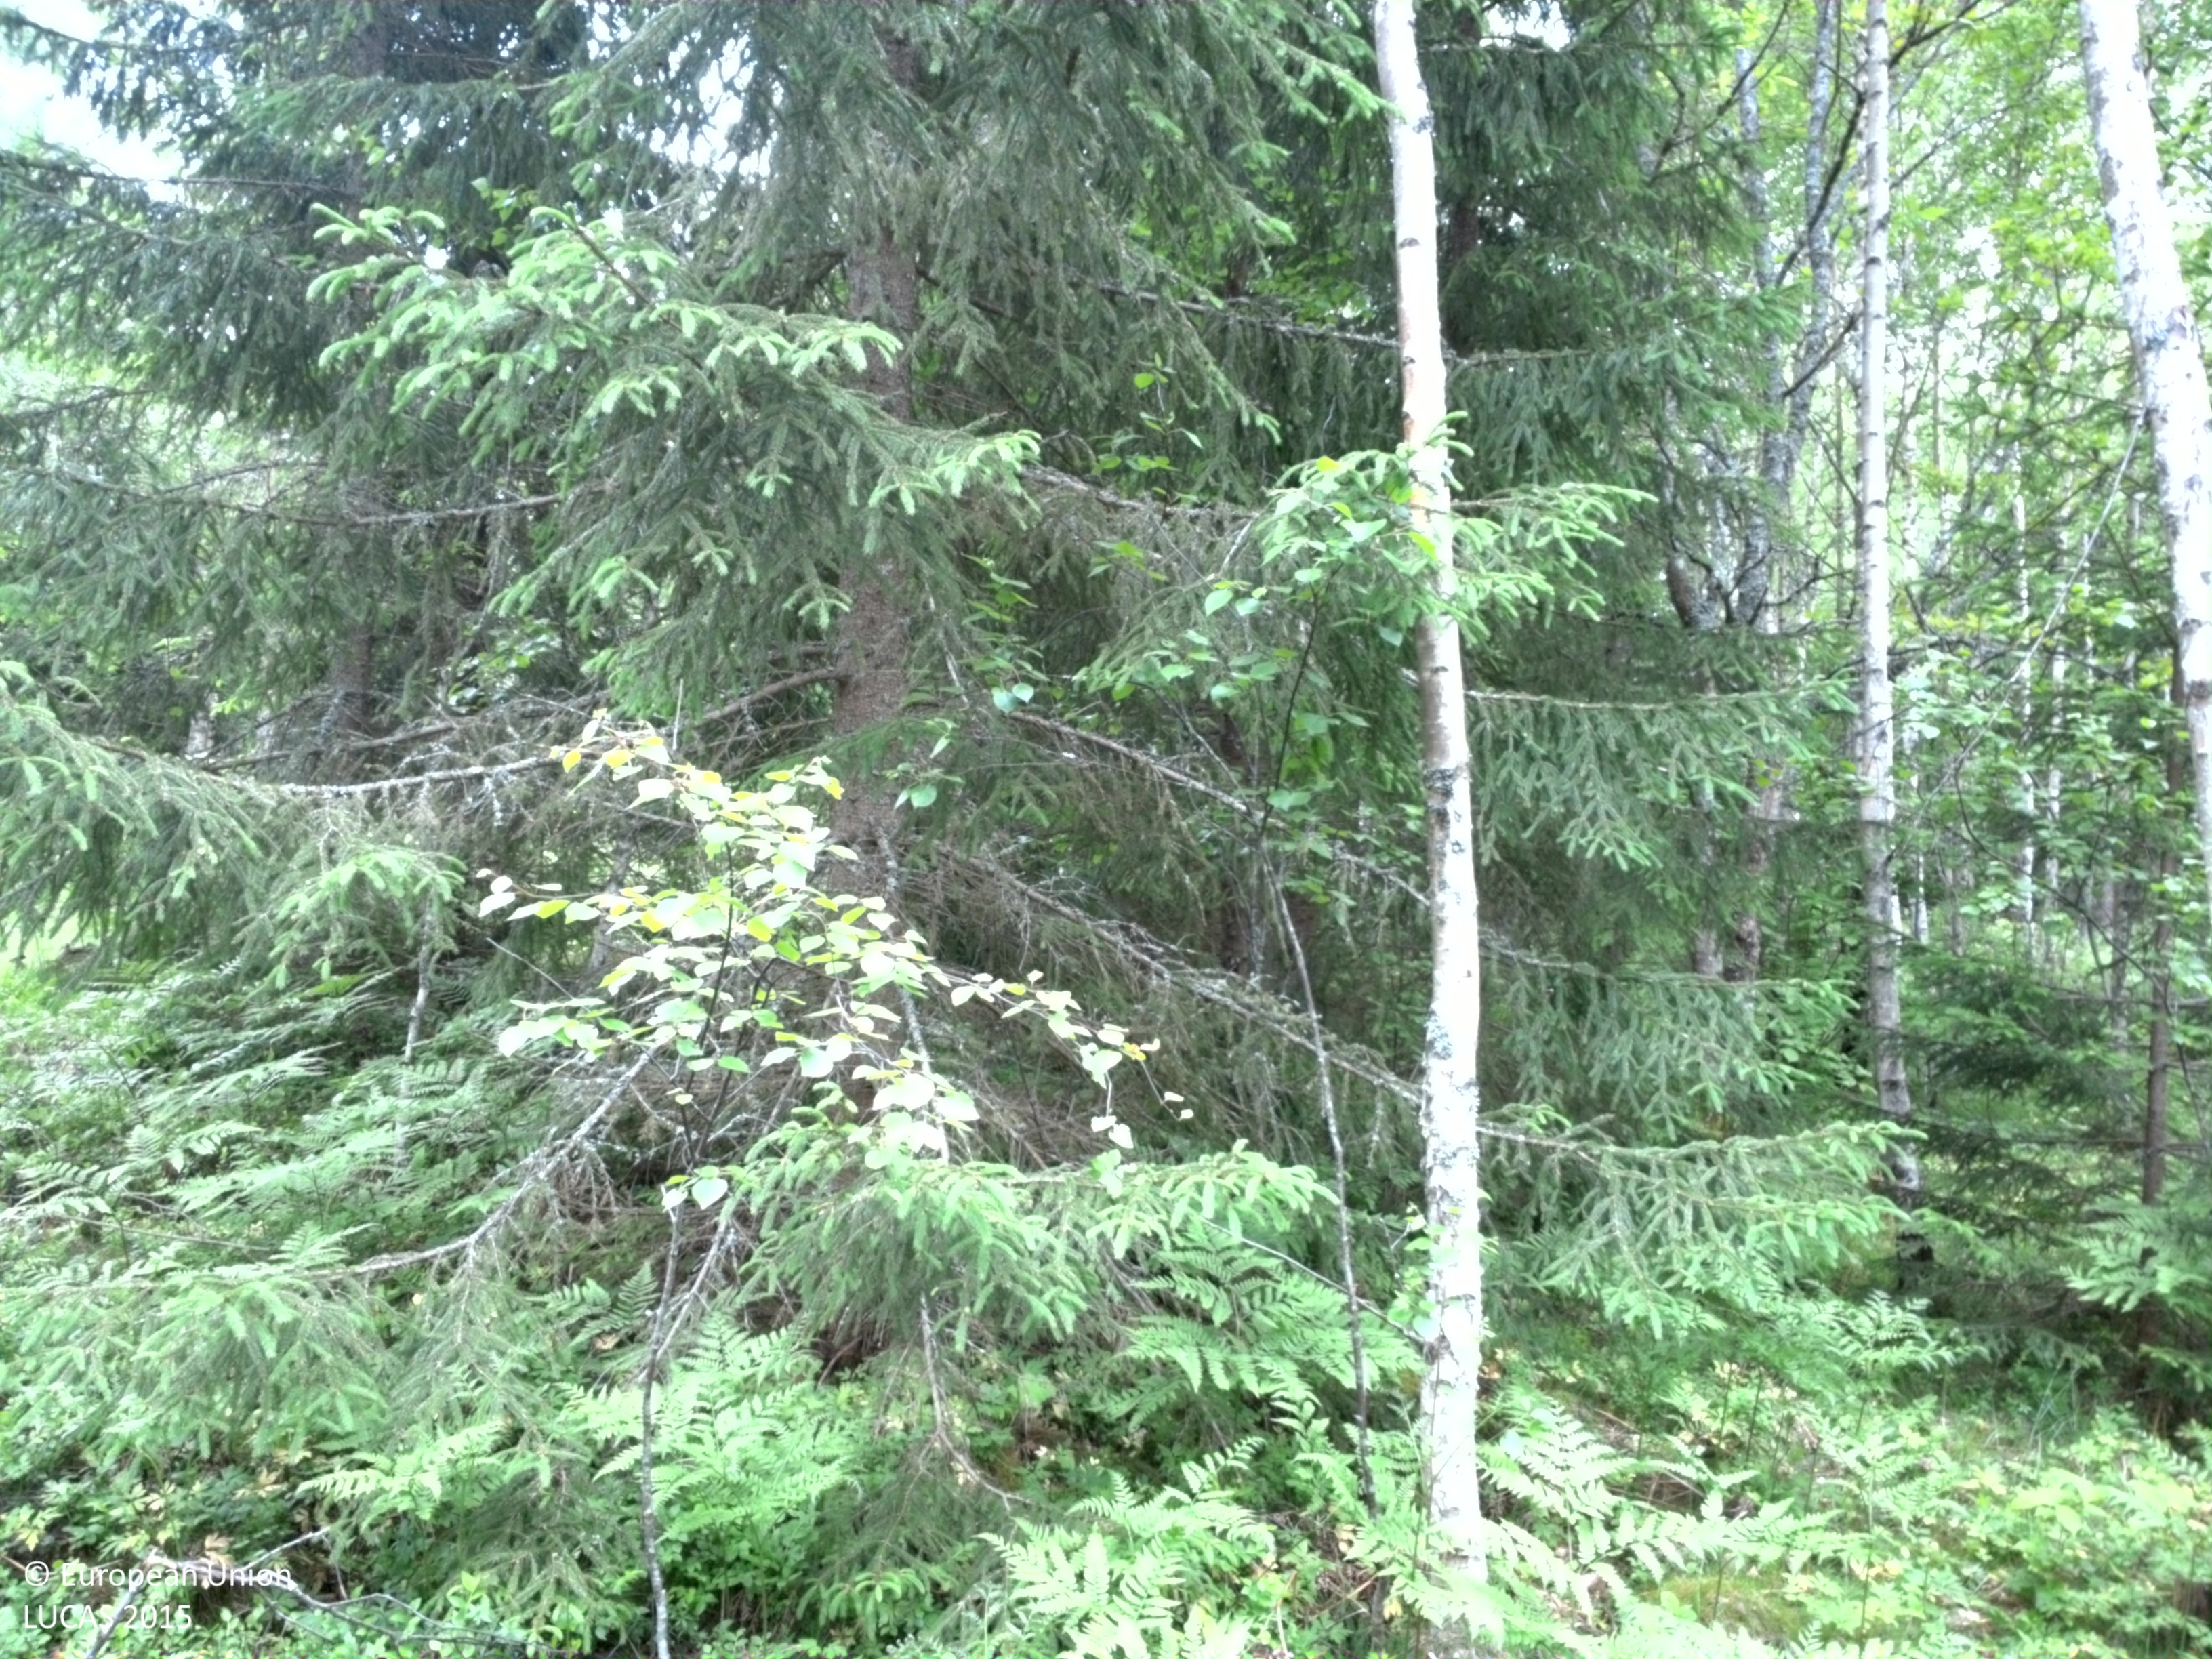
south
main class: Woodland
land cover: Spruce dominated mixed woodland
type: boreal forest
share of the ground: 50 - 75 %
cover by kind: coniferous forest trees 45 %, herbaceous plants 30 %, broadleaved forest trees 15 %, lichens and mosses 10 %
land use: Forestry
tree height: > 5 m
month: June
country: SE
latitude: 59.6905
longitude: 18.7586
